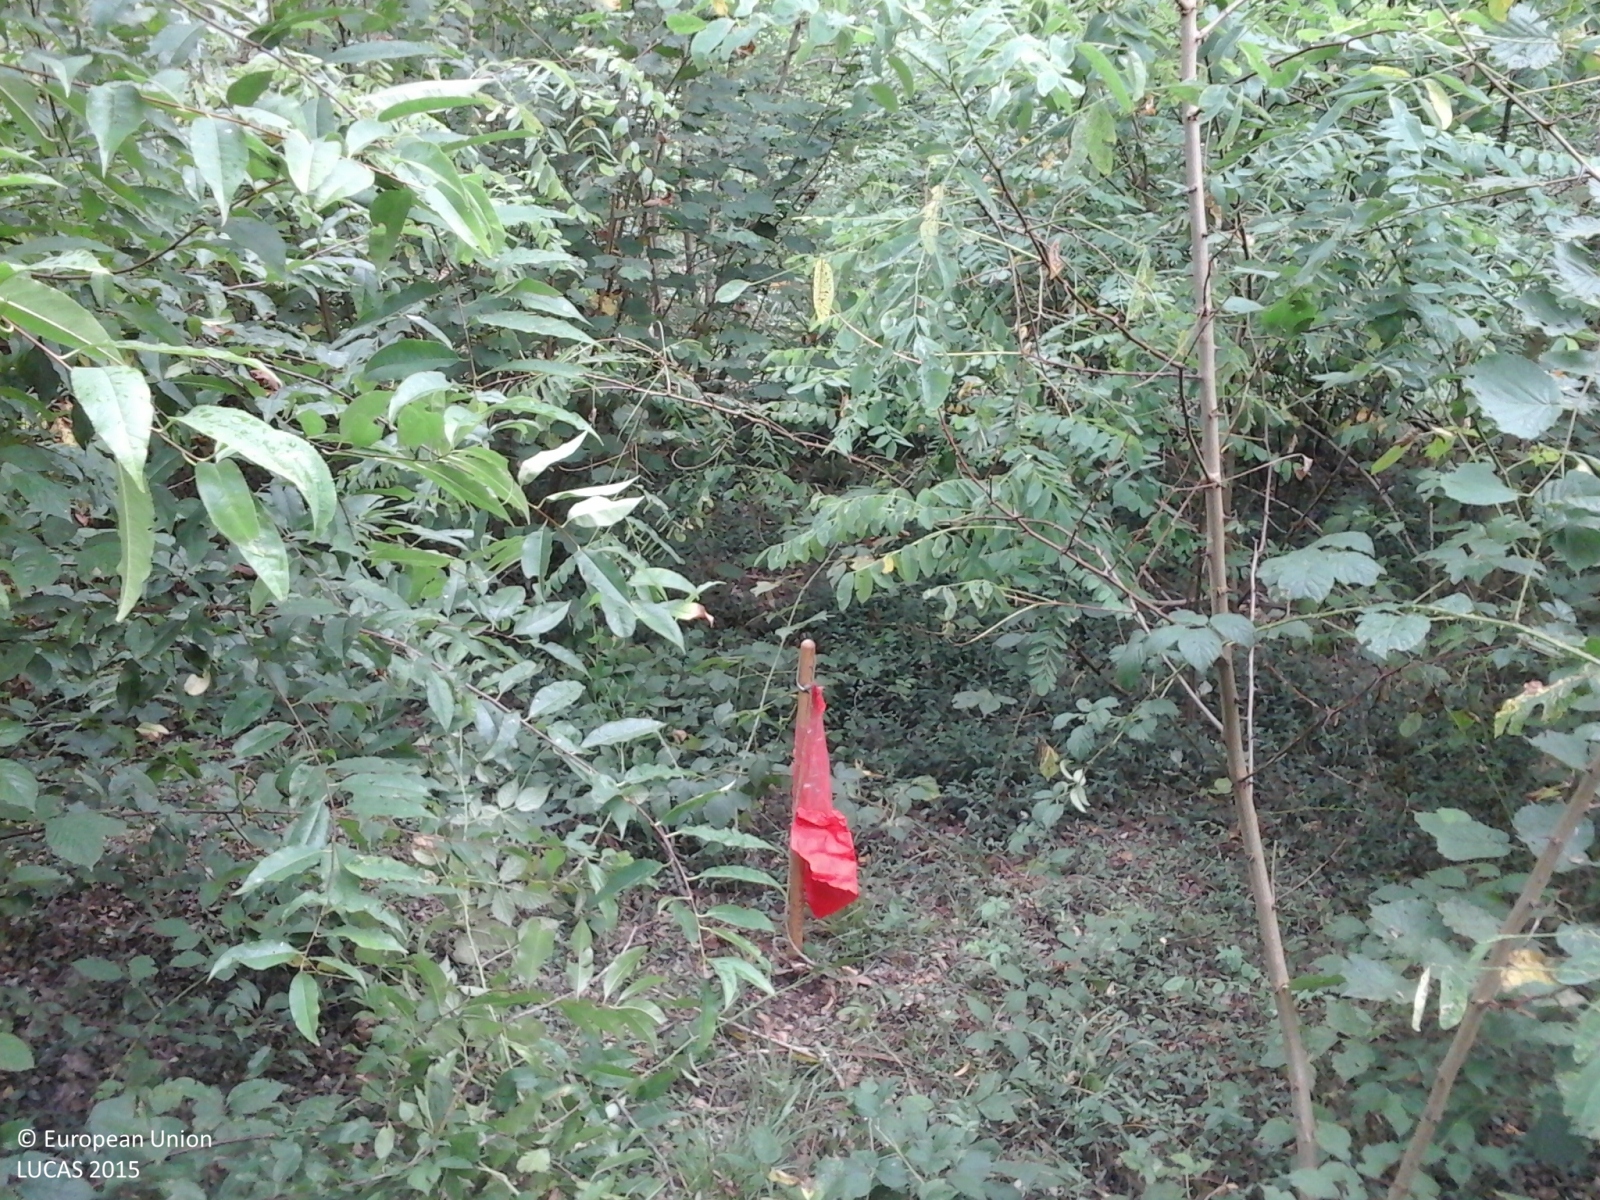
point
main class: Woodland
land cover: Broadleaved woodland
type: thermophilous deciduous forest
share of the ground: > 75 %
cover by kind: broadleaved forest trees 90 %, herbaceous plants 10 %
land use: Forestry
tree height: > 5 m
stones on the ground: < 10 %
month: August
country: IT
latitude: 45.6435
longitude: 8.9624
